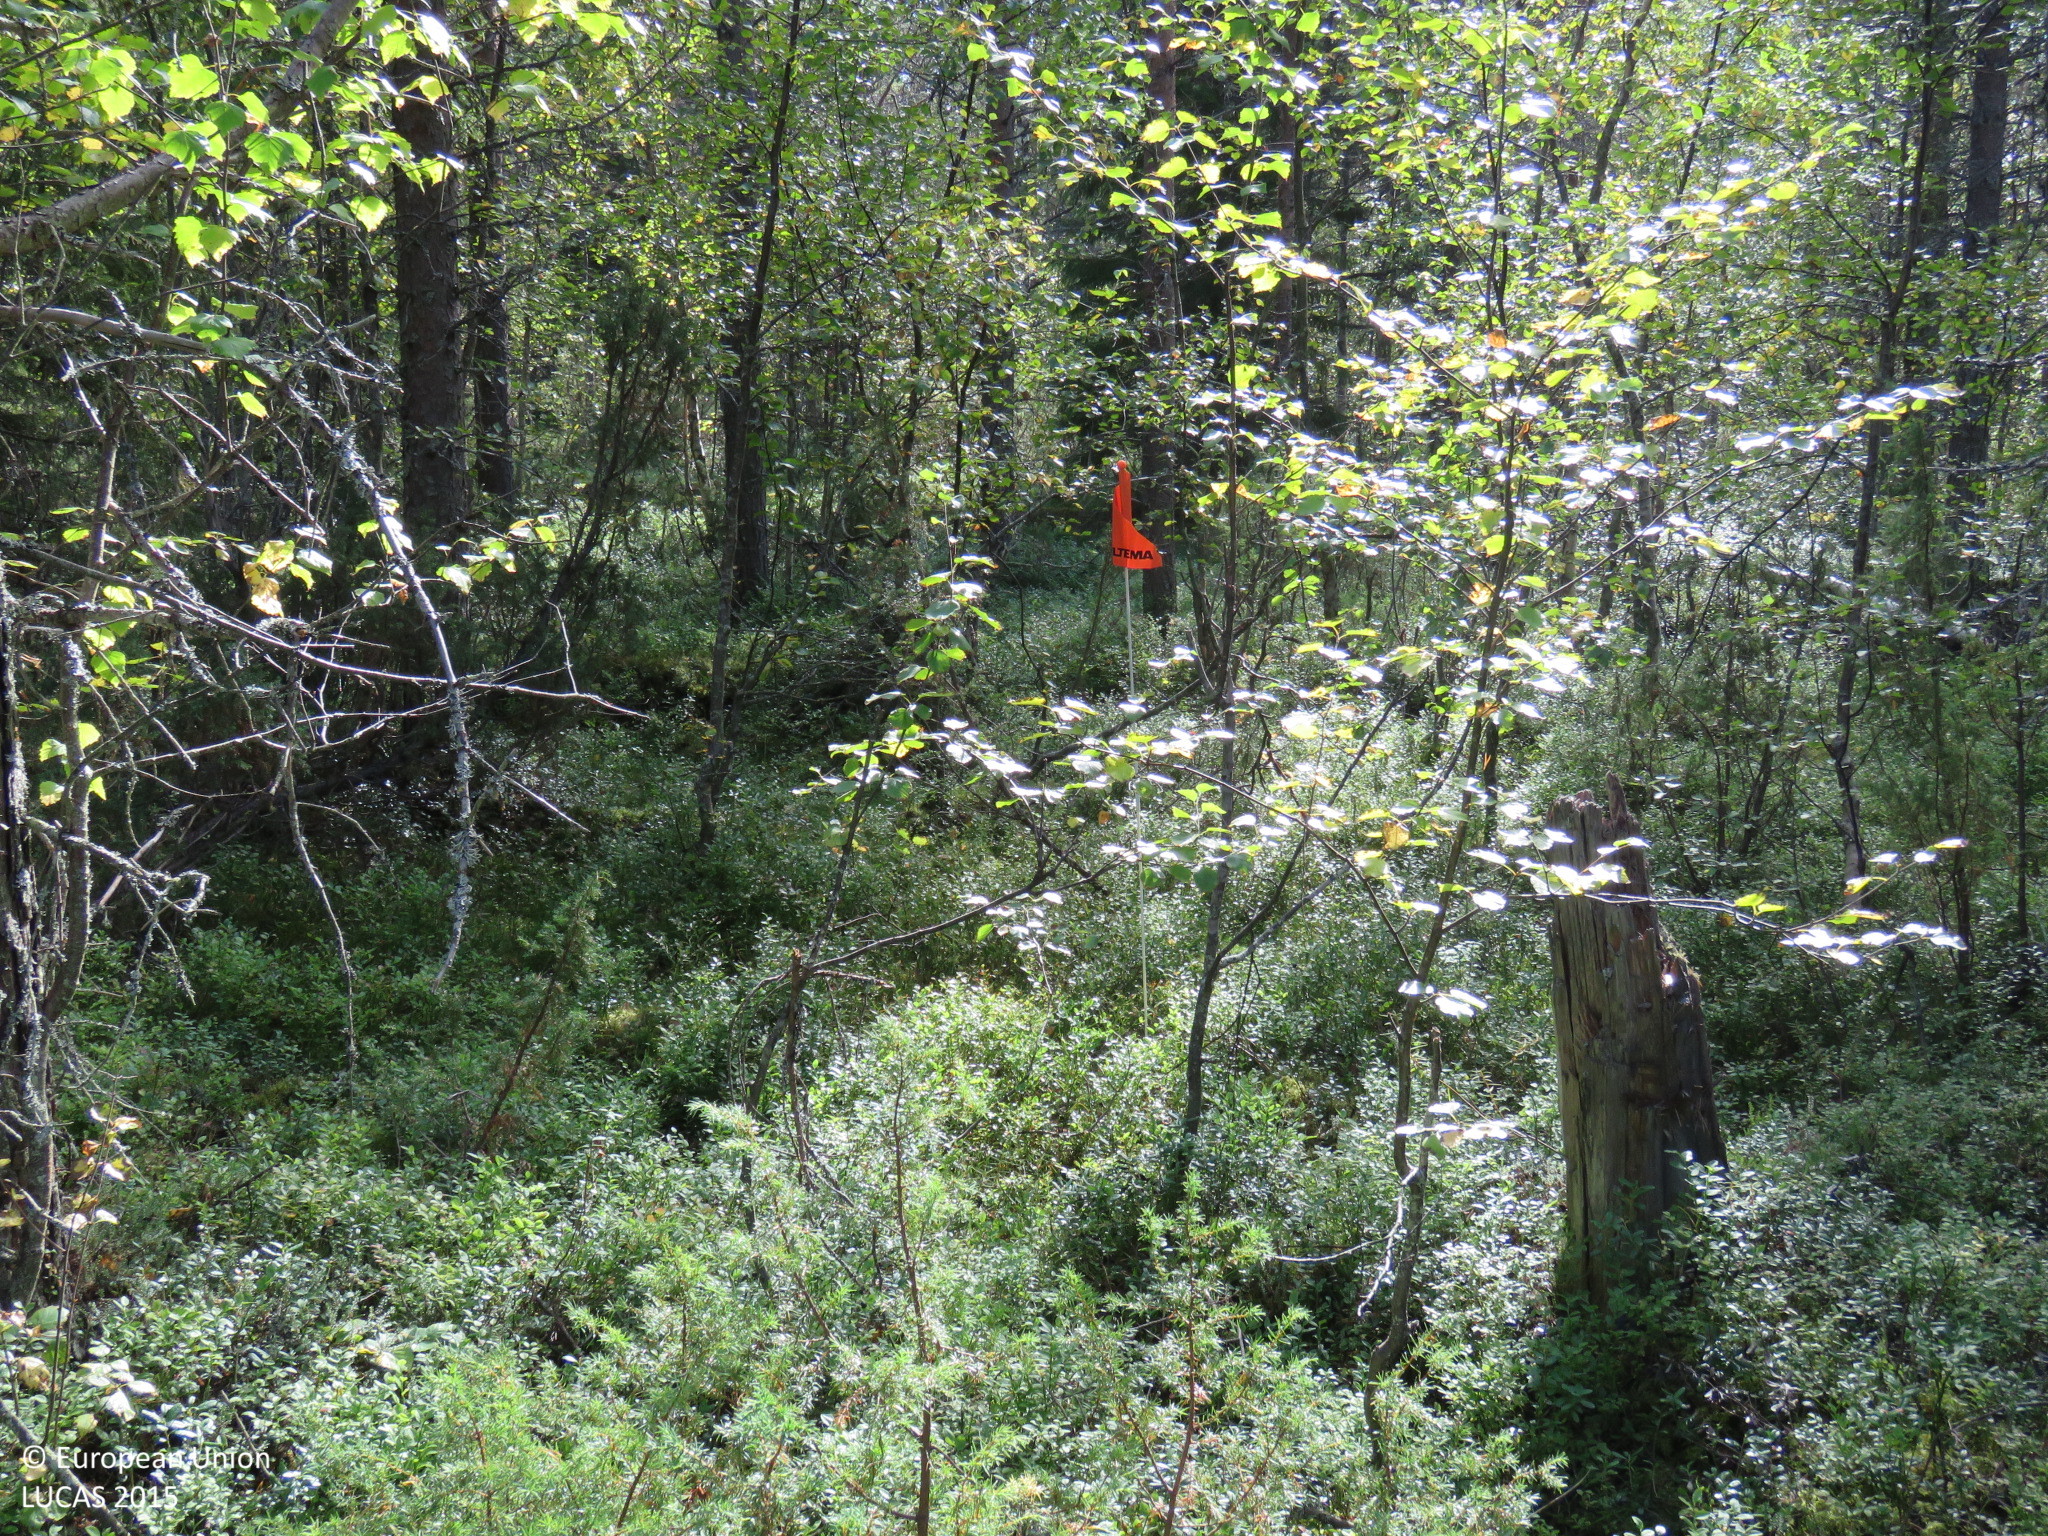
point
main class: Woodland
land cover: Other mixed woodland
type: boreal forest
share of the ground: > 75 %
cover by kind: coniferous forest trees 50 %, broadleaved forest trees 25 %, shrubs 20 %, lichens and mosses 5 %
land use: Forestry
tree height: > 5 m
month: September
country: FI
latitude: 65.4088
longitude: 27.6439
